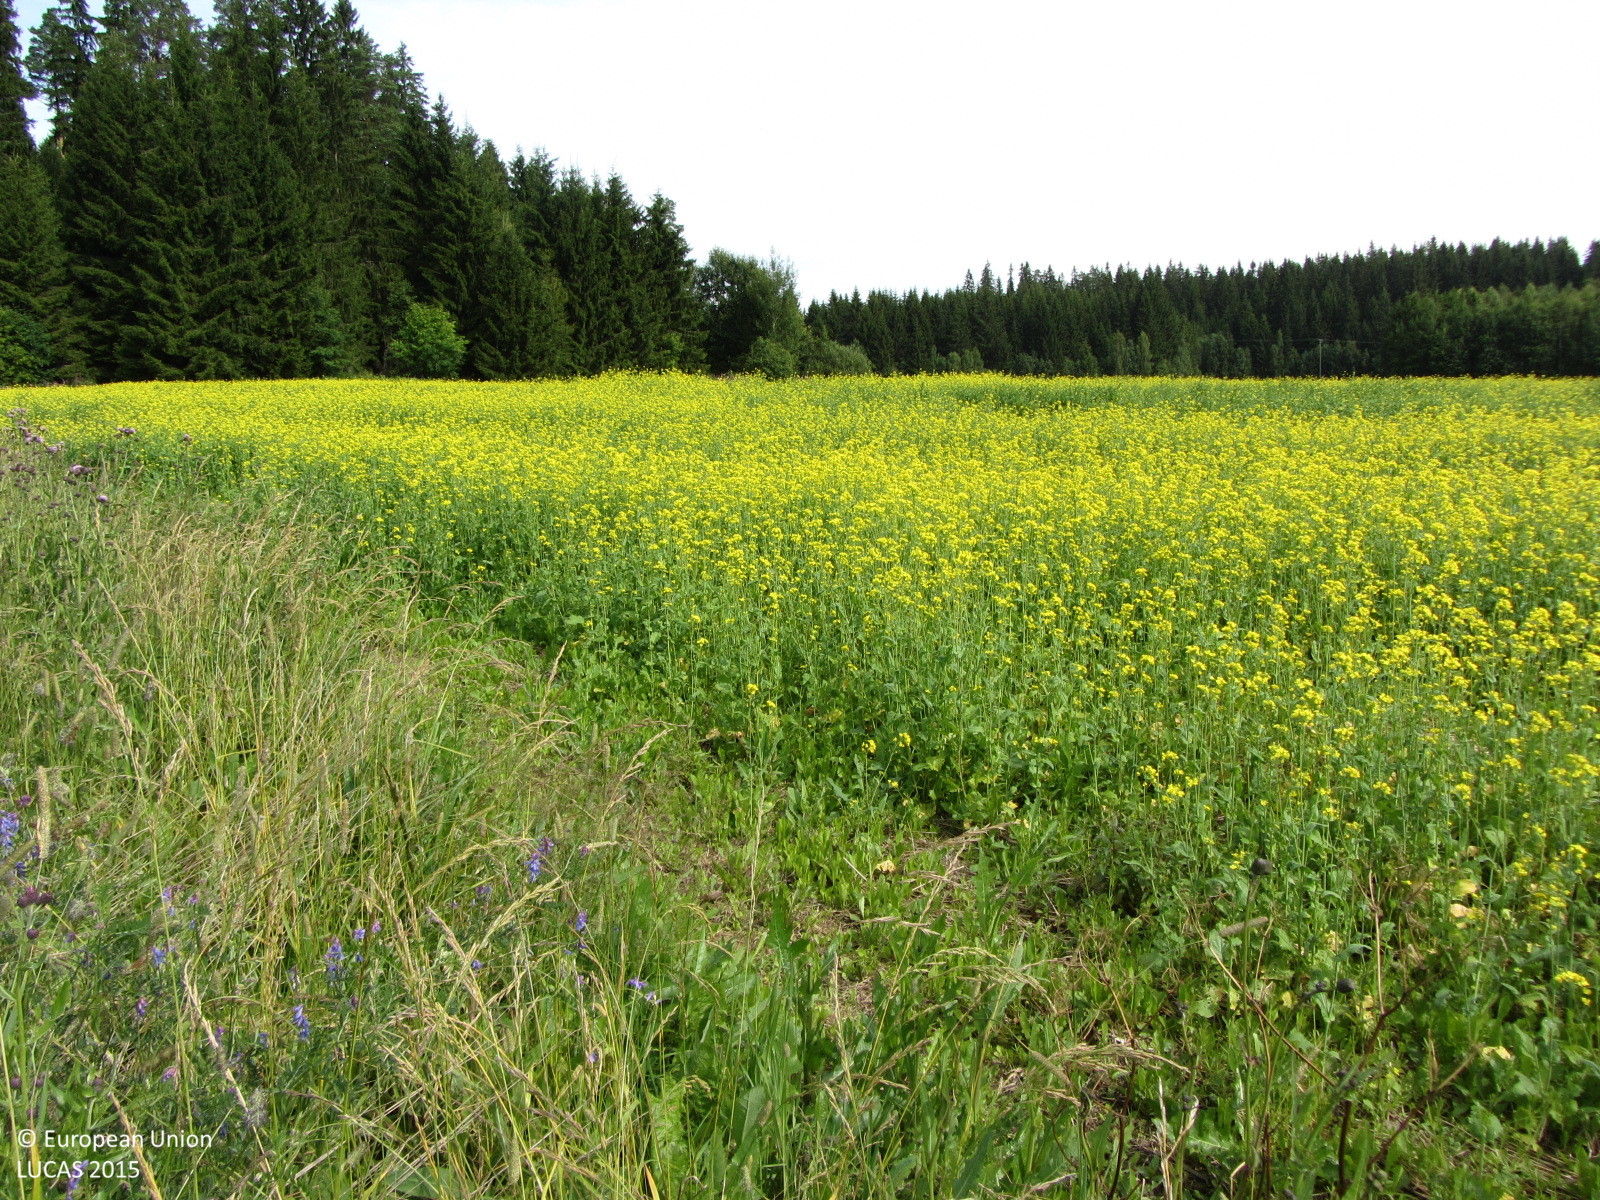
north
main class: Grassland
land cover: Spontaneously vegetated surfaces
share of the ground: > 75 %
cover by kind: herbaceous plants 100 %
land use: Fallow land
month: July
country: FI
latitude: 60.5784
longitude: 24.3557
